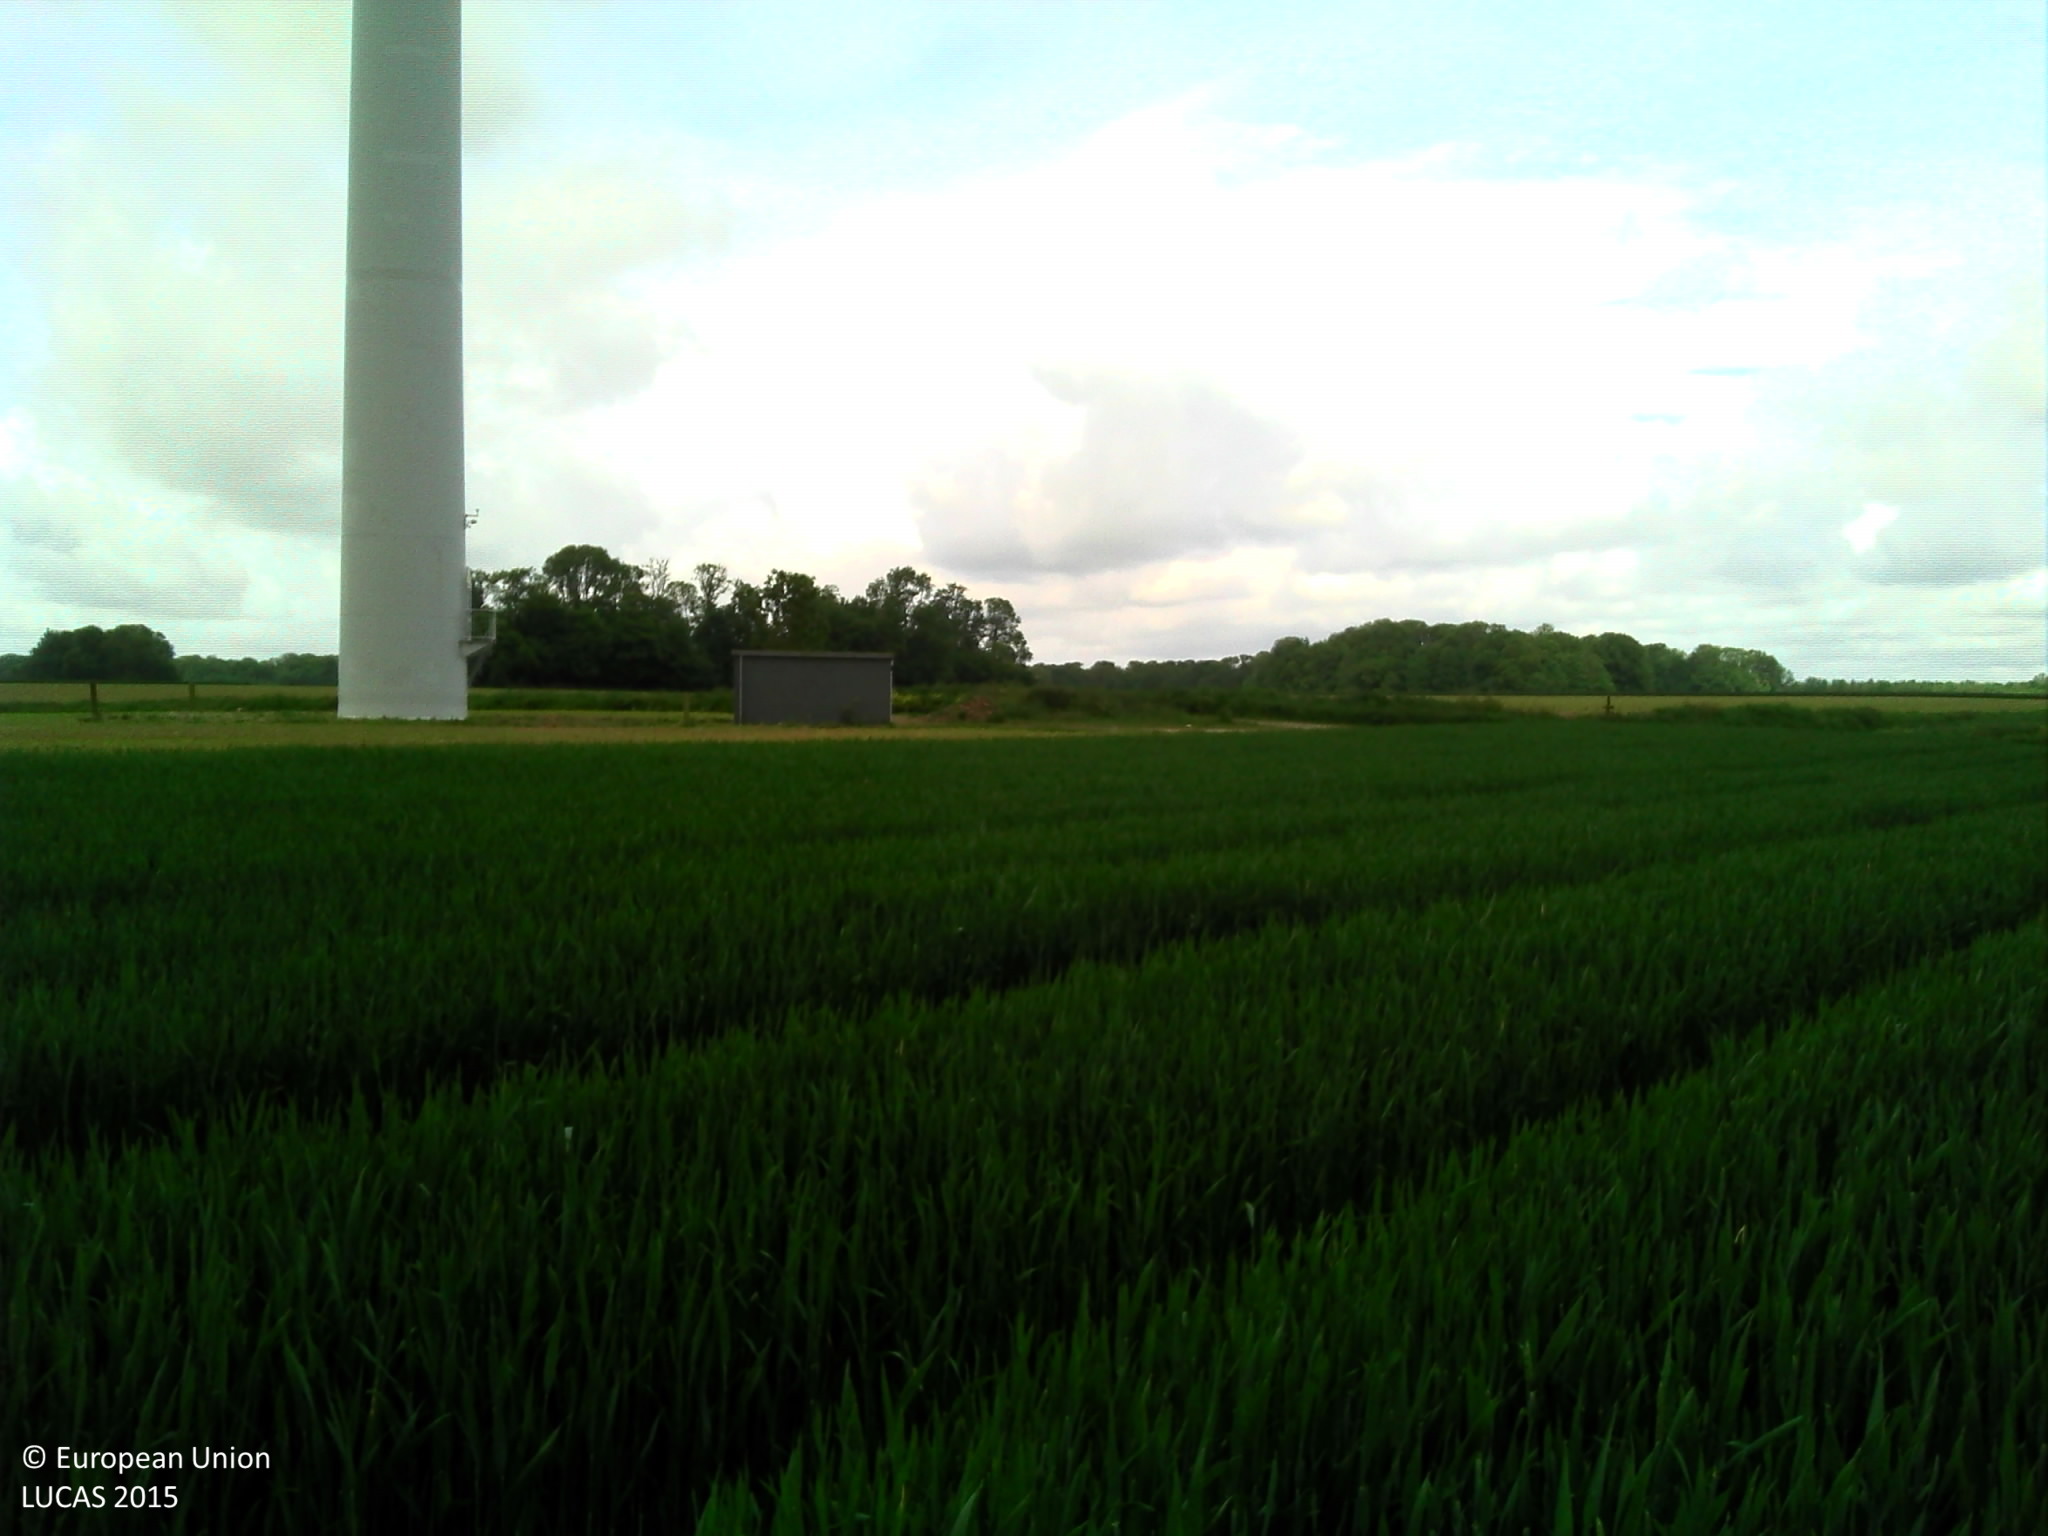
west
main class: Cropland
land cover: Common wheat
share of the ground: > 75 %
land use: Agriculture (excluding fallow land and kitchen gardens)
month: May
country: FR
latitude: 50.4745
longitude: 2.1650
